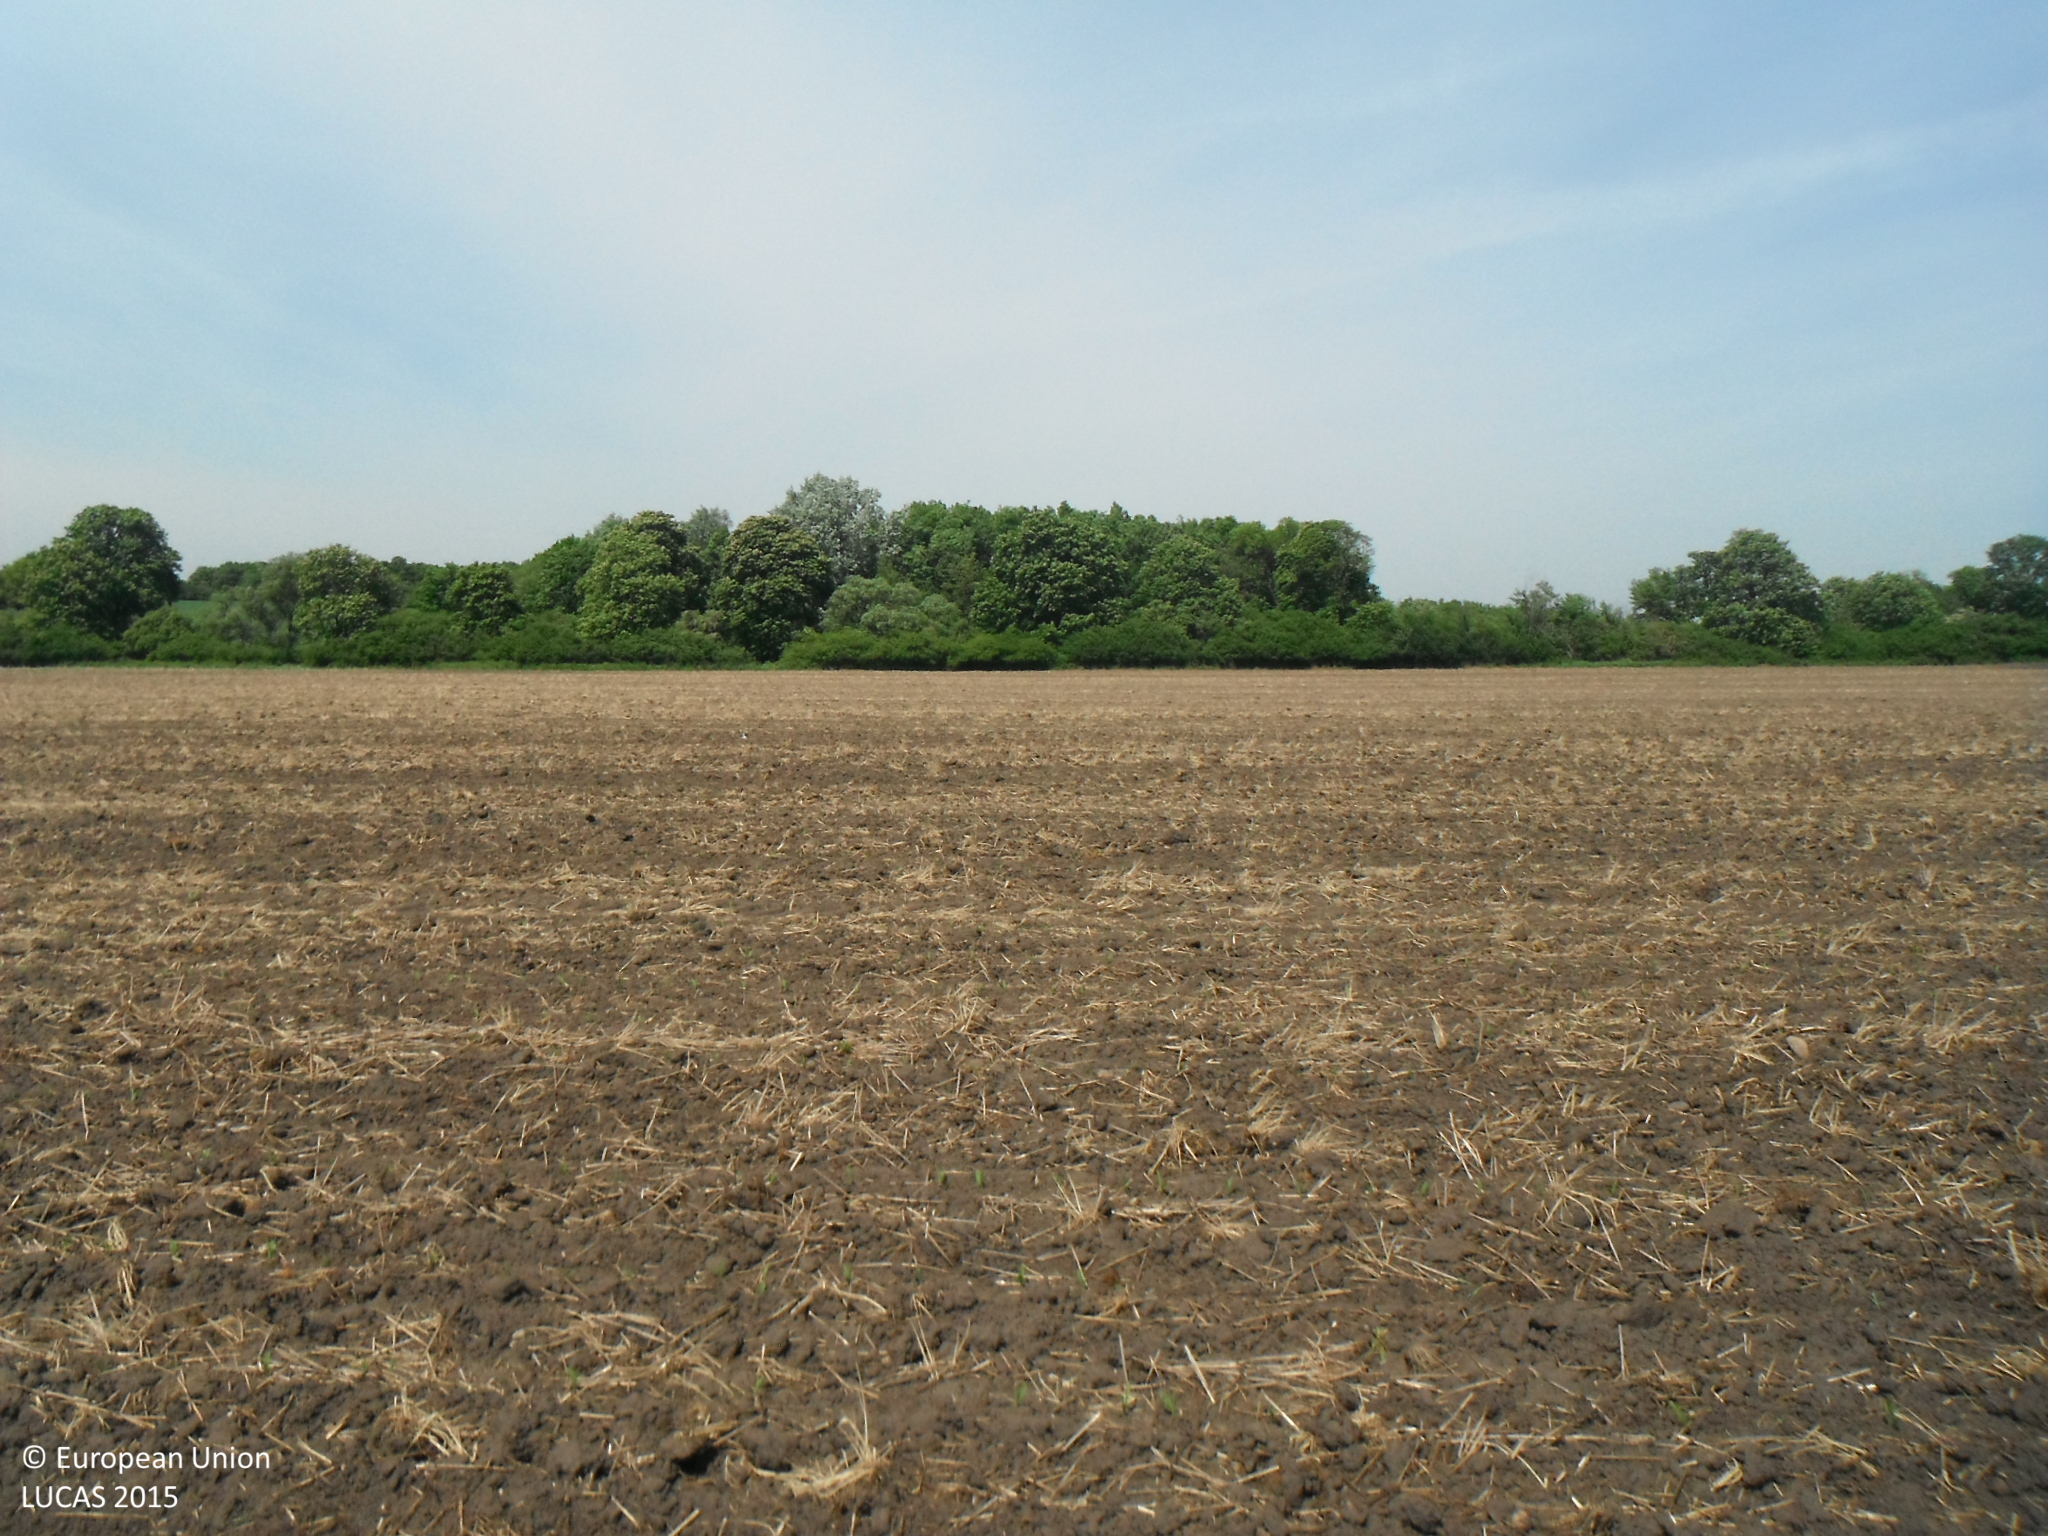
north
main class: Cropland
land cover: Maize
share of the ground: < 10 %
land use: Agriculture (excluding fallow land and kitchen gardens)
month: May
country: SK
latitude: 48.2718
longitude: 17.0004
